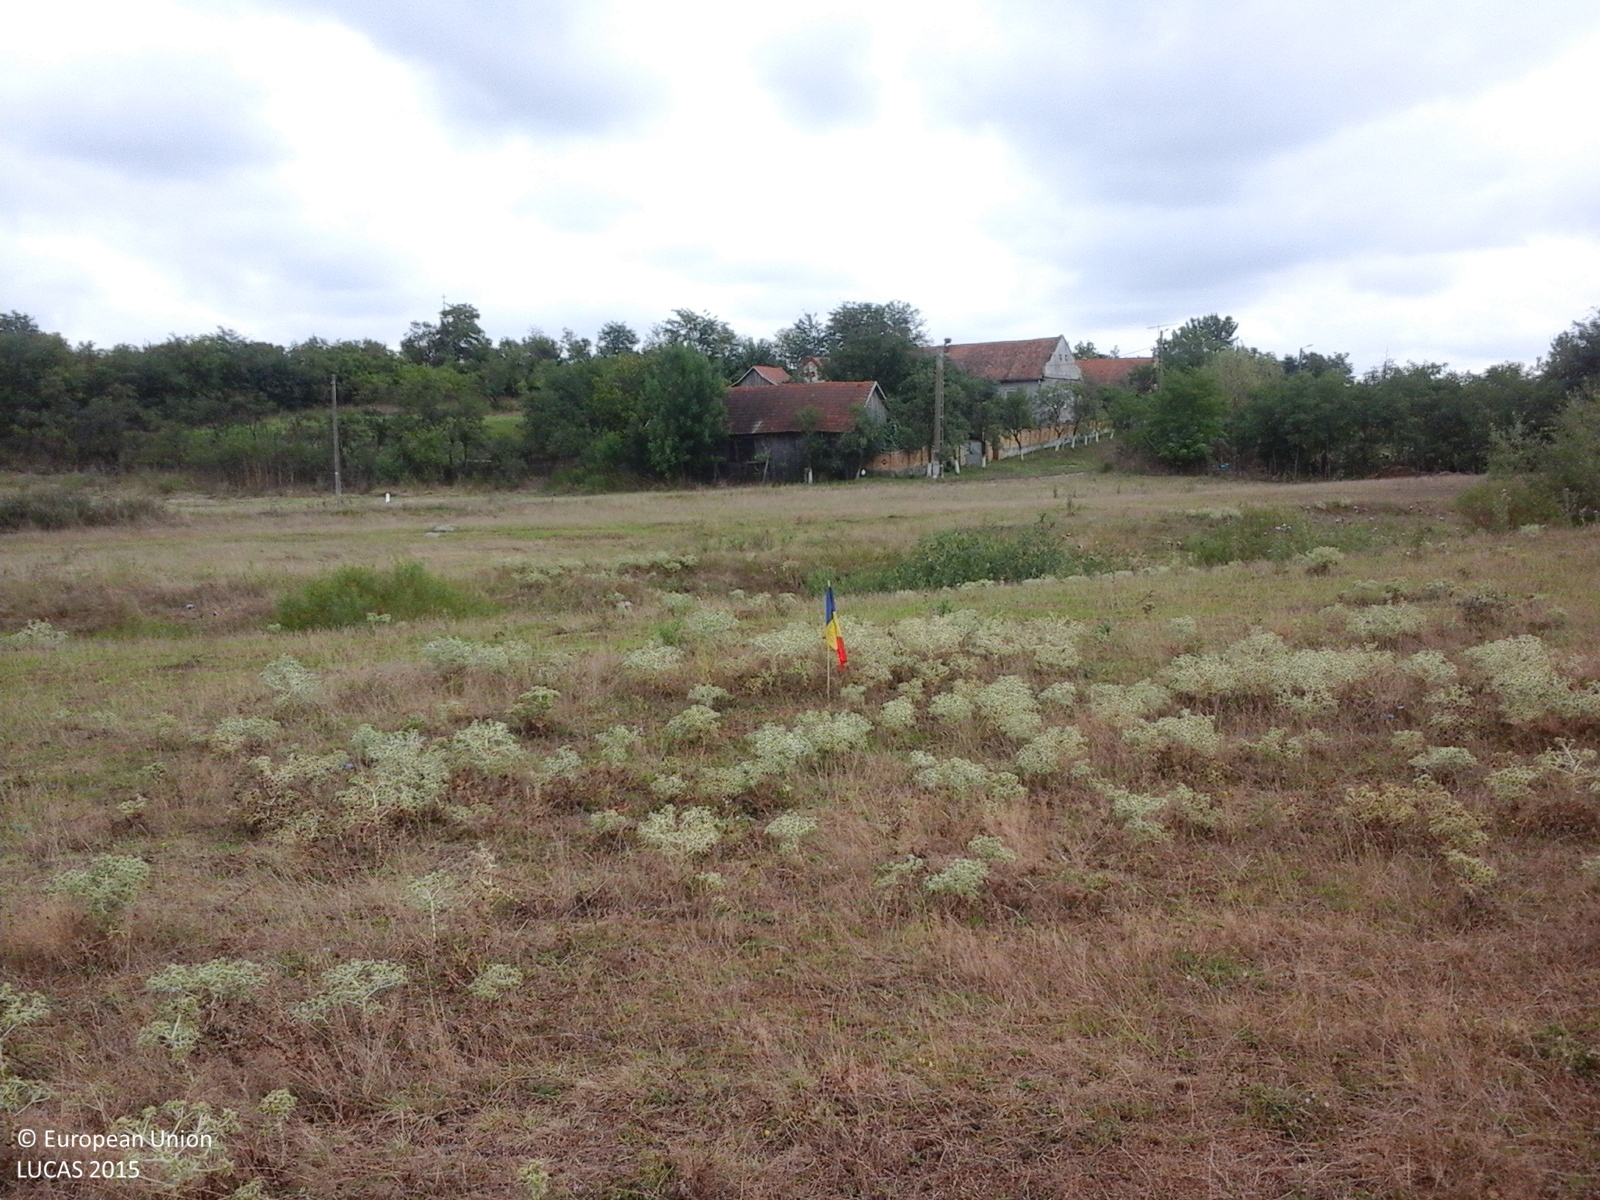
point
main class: Grassland
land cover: Grassland without tree/shrub cover
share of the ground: > 75 %
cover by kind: herbaceous plants 100 %
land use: Agriculture (excluding fallow land and kitchen gardens)
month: August
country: RO
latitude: 45.8063
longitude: 21.7857
